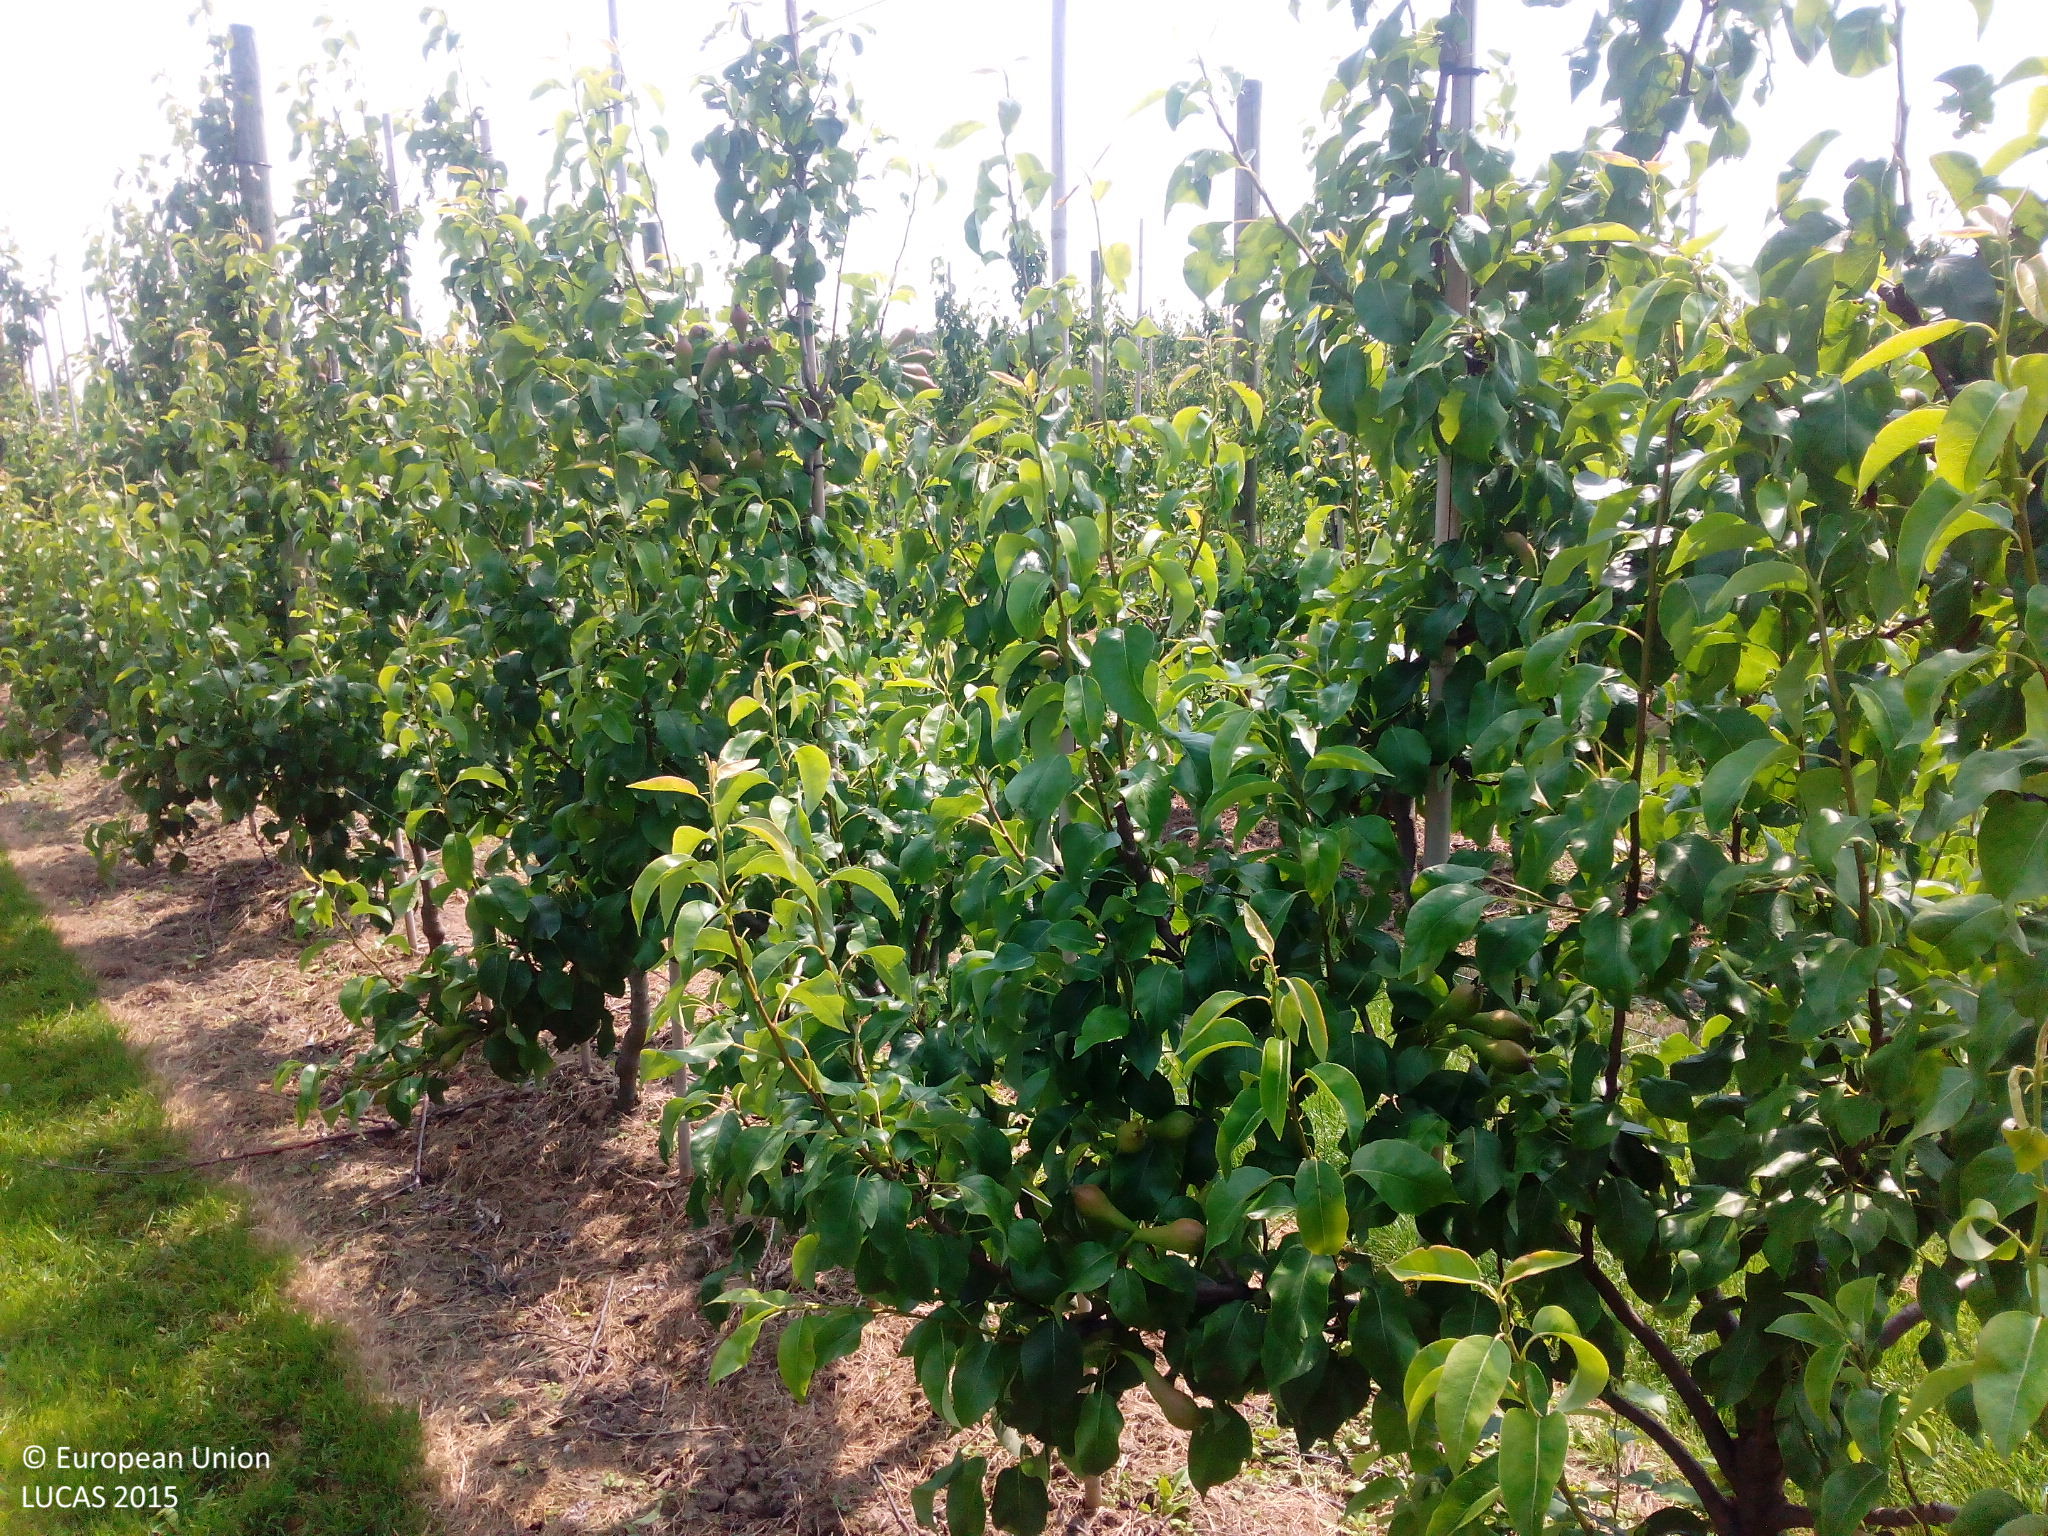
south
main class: Cropland
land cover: Pear fruit
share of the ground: 50 - 75 %
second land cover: Grassland without tree/shrub cover
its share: 25 - 50 %
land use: Agriculture (excluding fallow land and kitchen gardens)
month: June
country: NL
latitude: 51.6642
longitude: 4.6904
